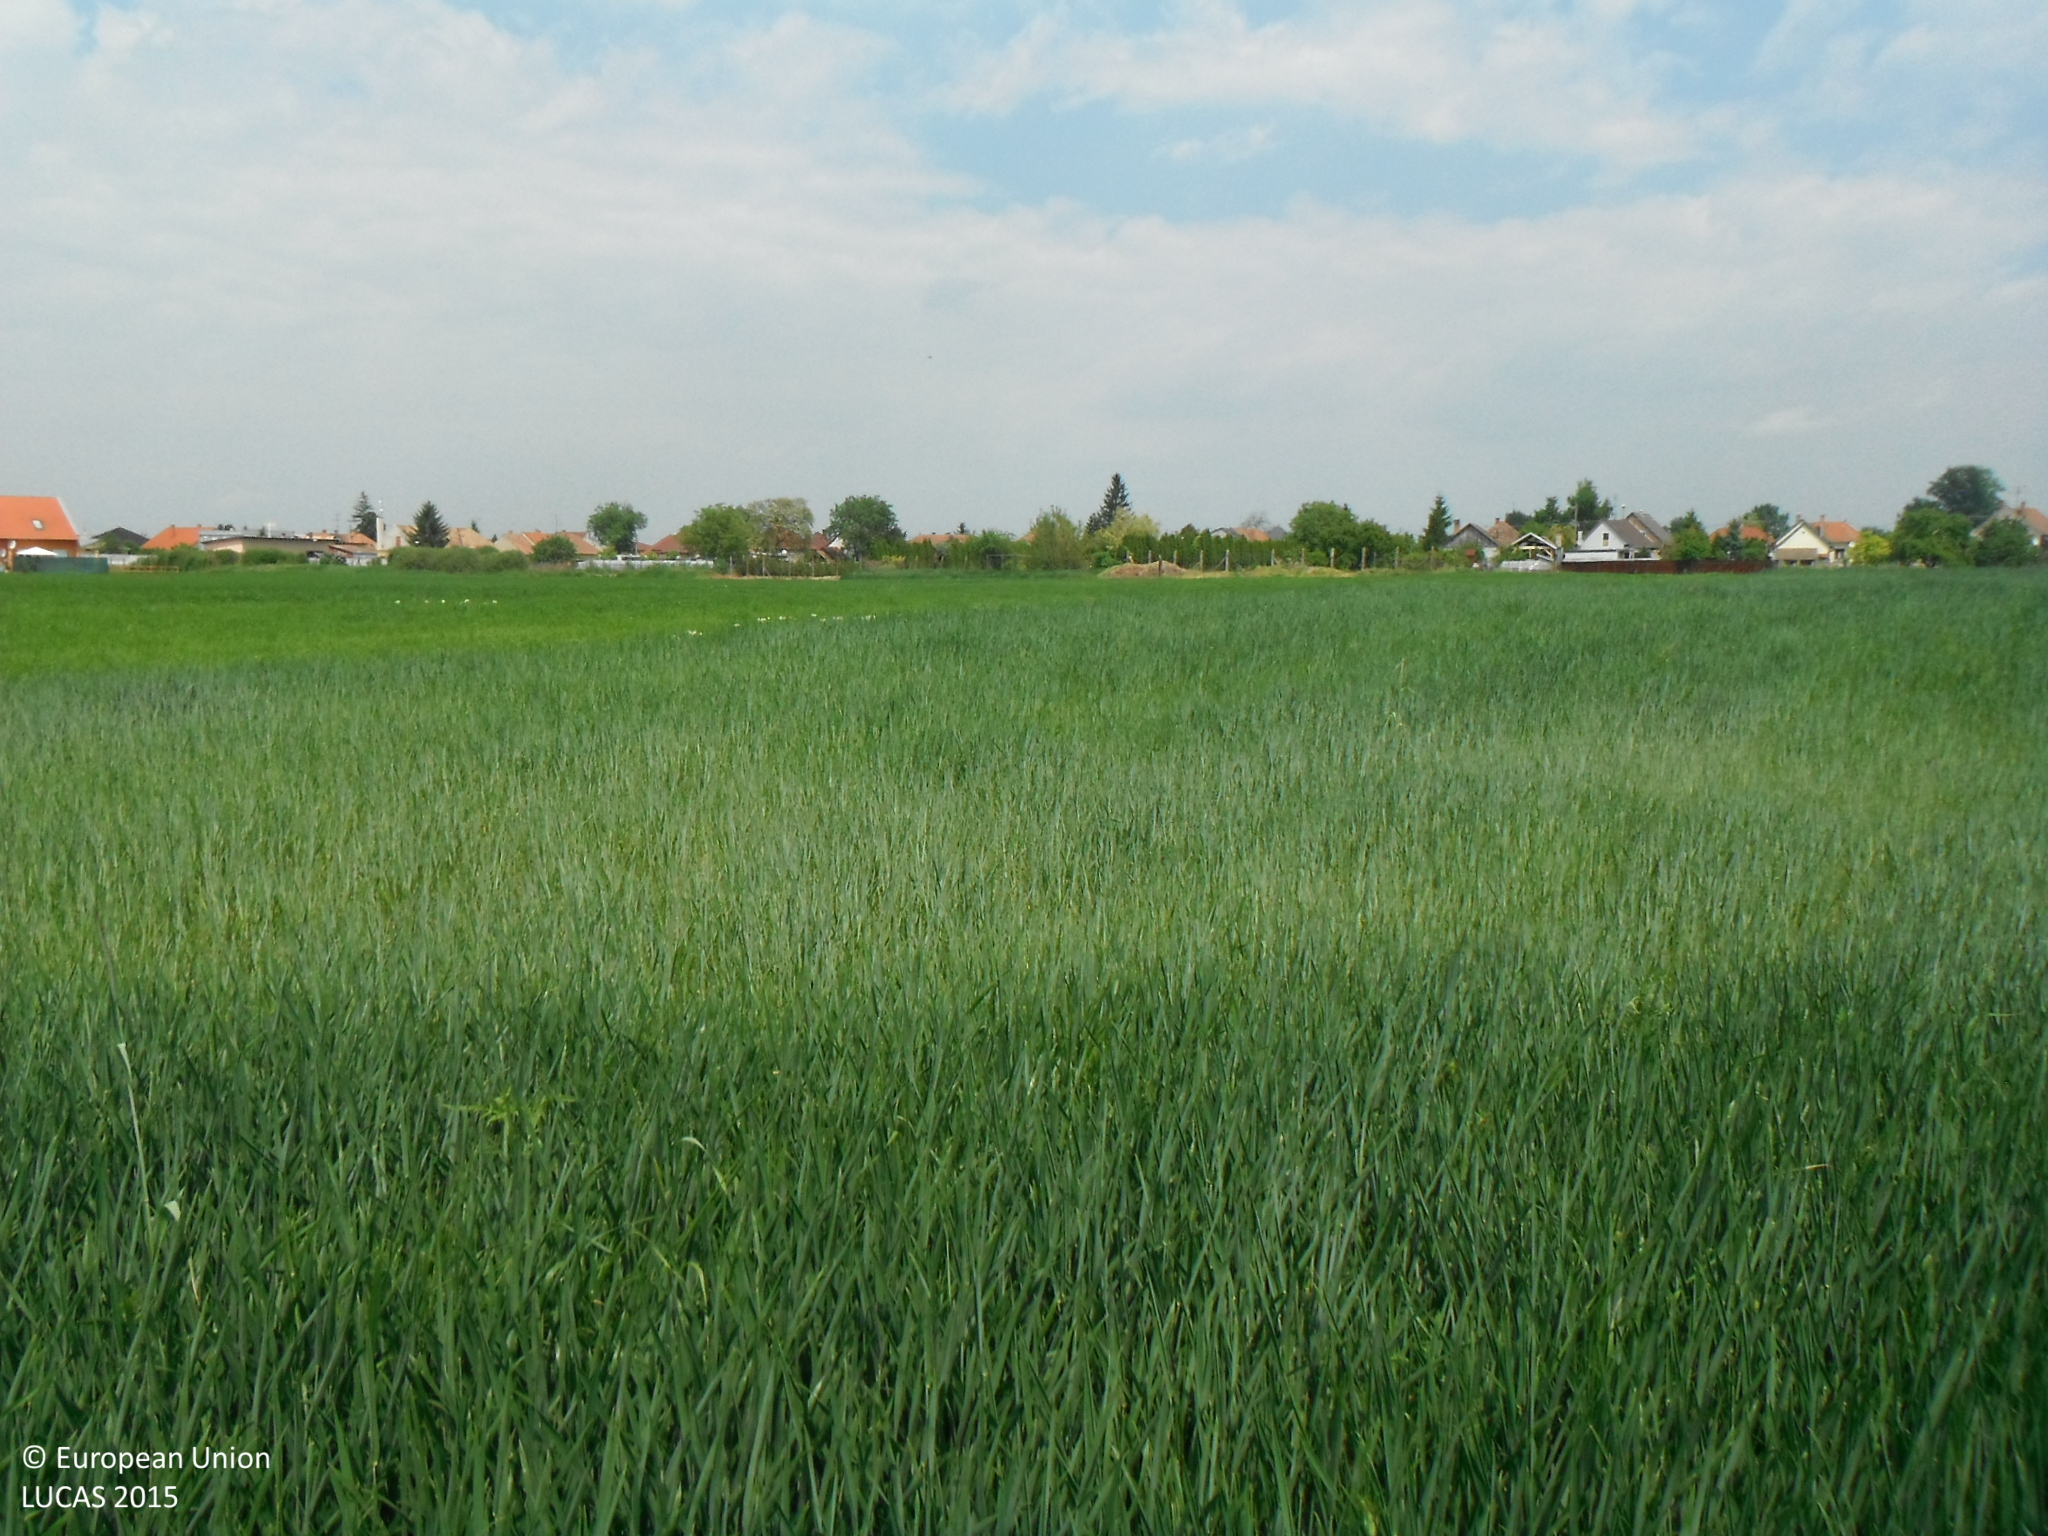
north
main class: Cropland
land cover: Common wheat
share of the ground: > 75 %
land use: Agriculture (excluding fallow land and kitchen gardens)
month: May
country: SK
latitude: 47.9749
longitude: 17.6594
